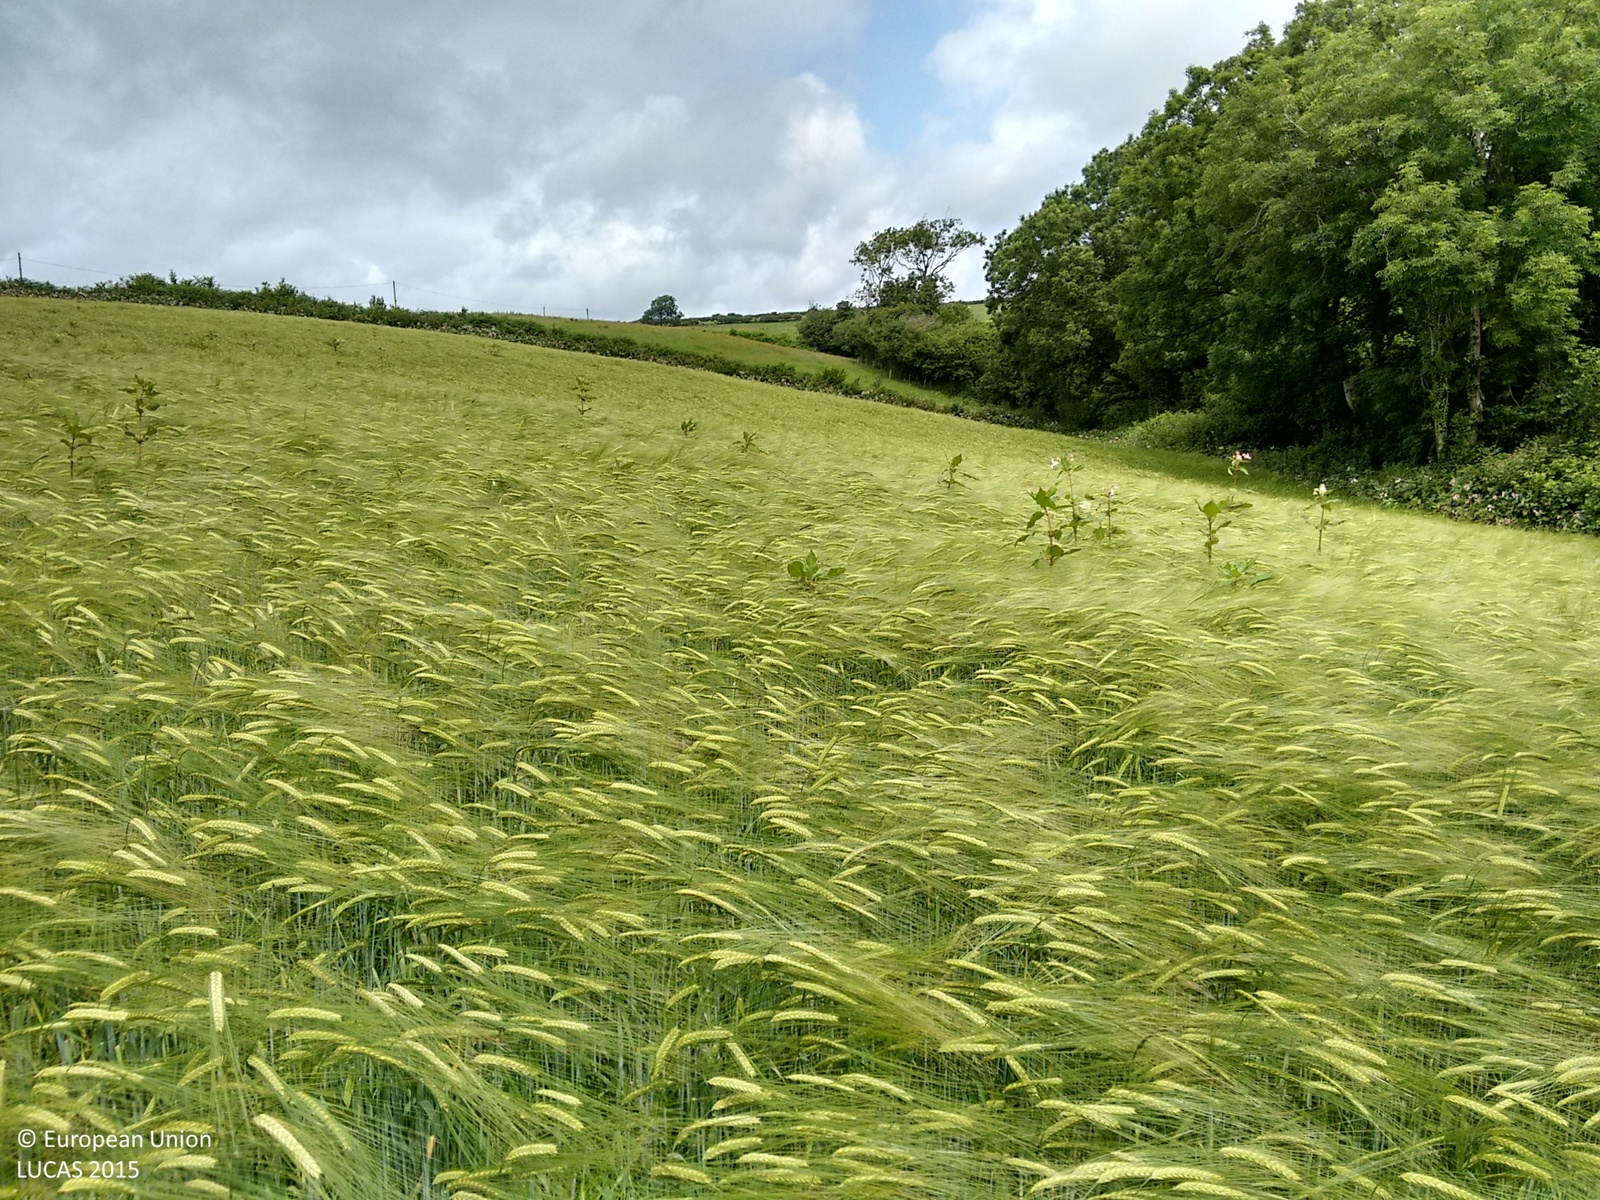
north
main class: Cropland
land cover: Barley
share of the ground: > 75 %
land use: Agriculture (excluding fallow land and kitchen gardens)
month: July
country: GB
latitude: 51.5501
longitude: -3.6286
